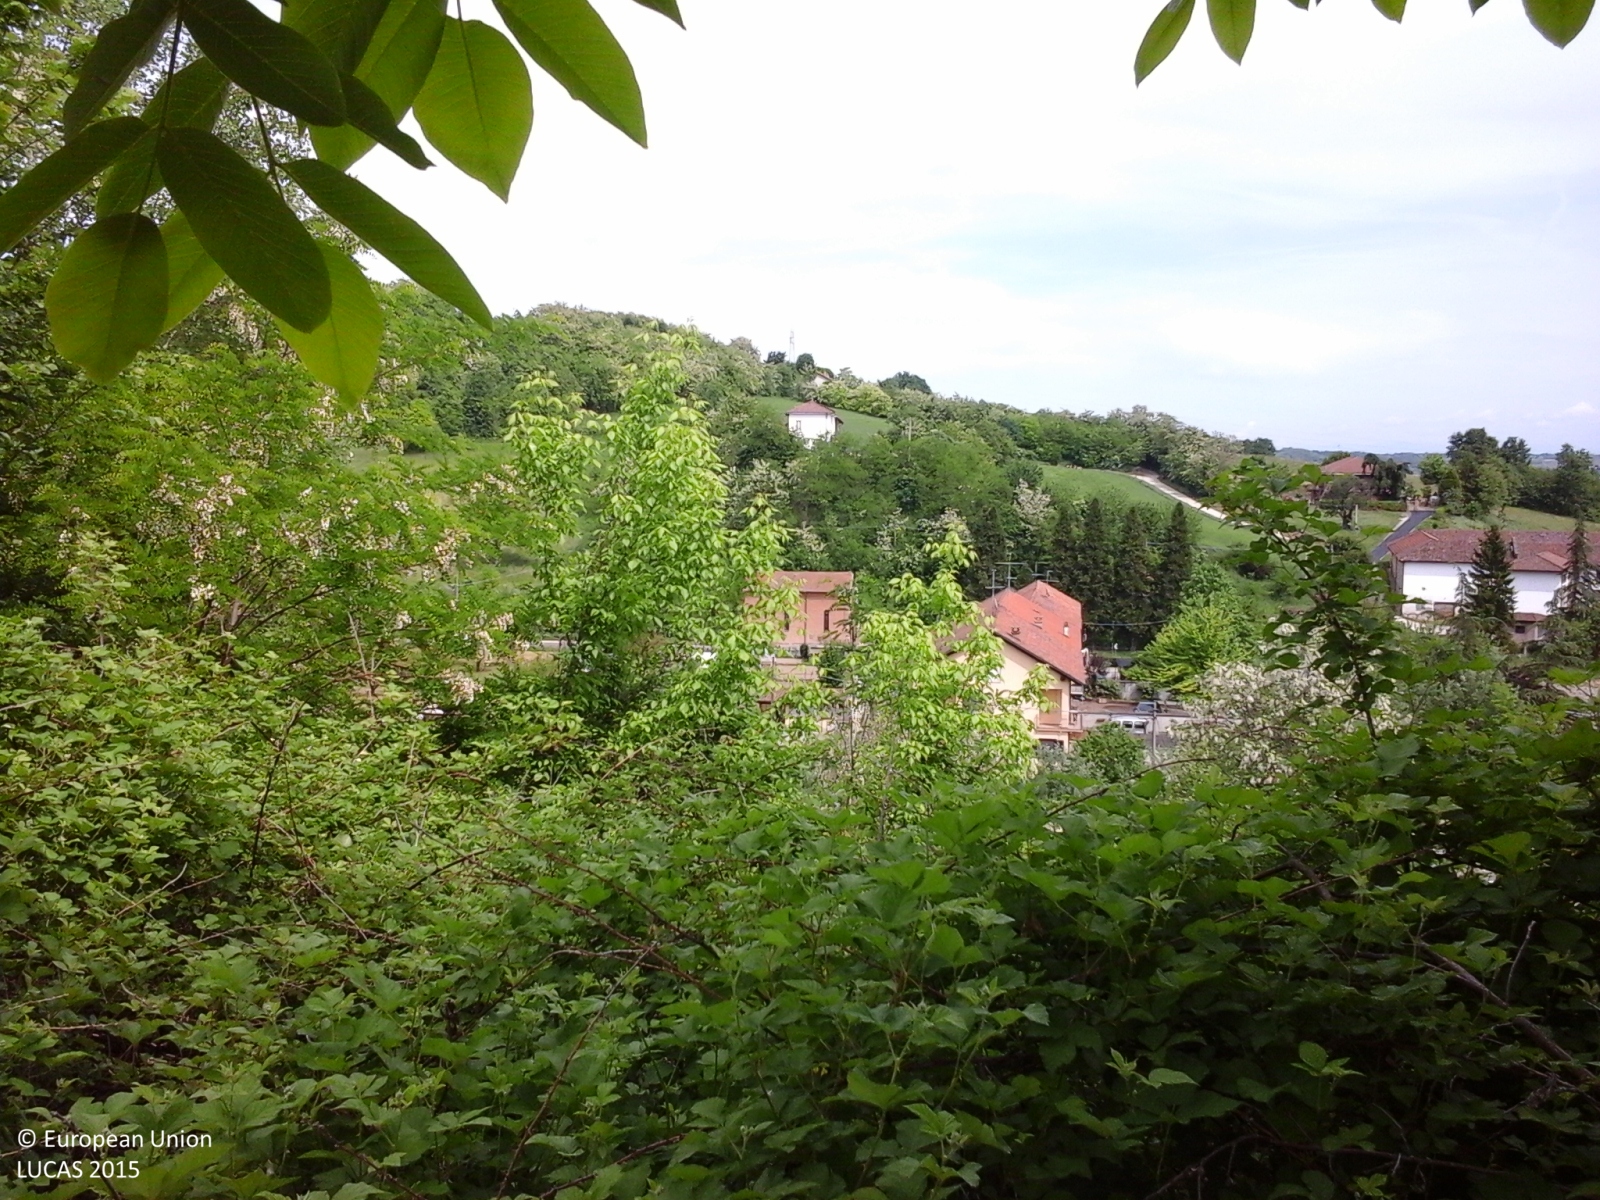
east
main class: Grassland
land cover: Grassland with sparse tree/shrub cover
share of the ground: > 75 %
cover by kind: herbaceous plants 85 %, shrubs 10 %, broadleaved forest trees 5 %
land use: Agriculture (excluding fallow land and kitchen gardens)
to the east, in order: Grassland with sparse tree/shrub cover; Paved roads, cycling and walking lanes; Grassland with sparse tree/shrub cover; Grassland without tree/shrub cover; Artificial constructions in urban areas; Broadleaved woodland; Tracks; Broadleaved woodland; Electric lines; Broadleaved woodland; Artificial constructions in urban areas
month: May
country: IT
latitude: 44.9128
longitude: 8.2427
